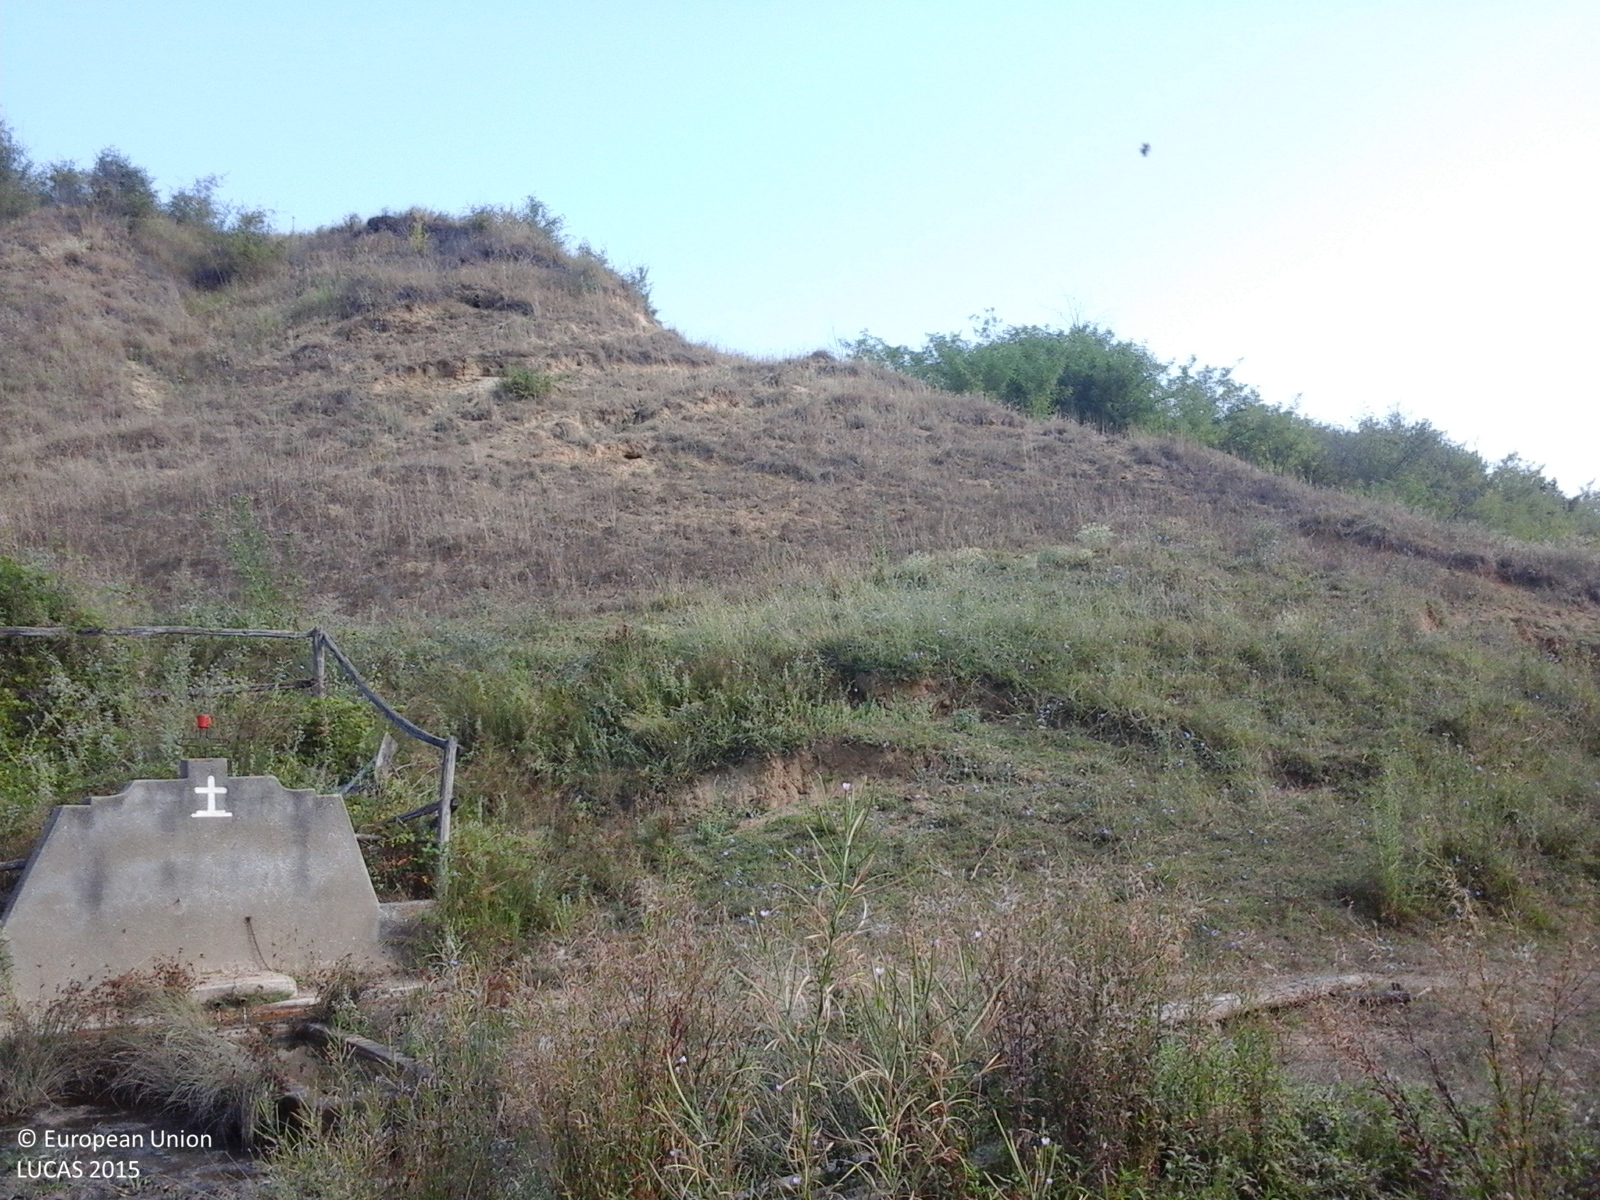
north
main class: Grassland
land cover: Grassland with sparse tree/shrub cover
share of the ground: > 75 %
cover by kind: herbaceous plants 85 %, shrubs 10 %, broadleaved forest trees 5 %
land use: Semi-natural and natural areas not in use
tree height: > 5 m
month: August
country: RO
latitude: 44.5738
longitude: 23.6696
